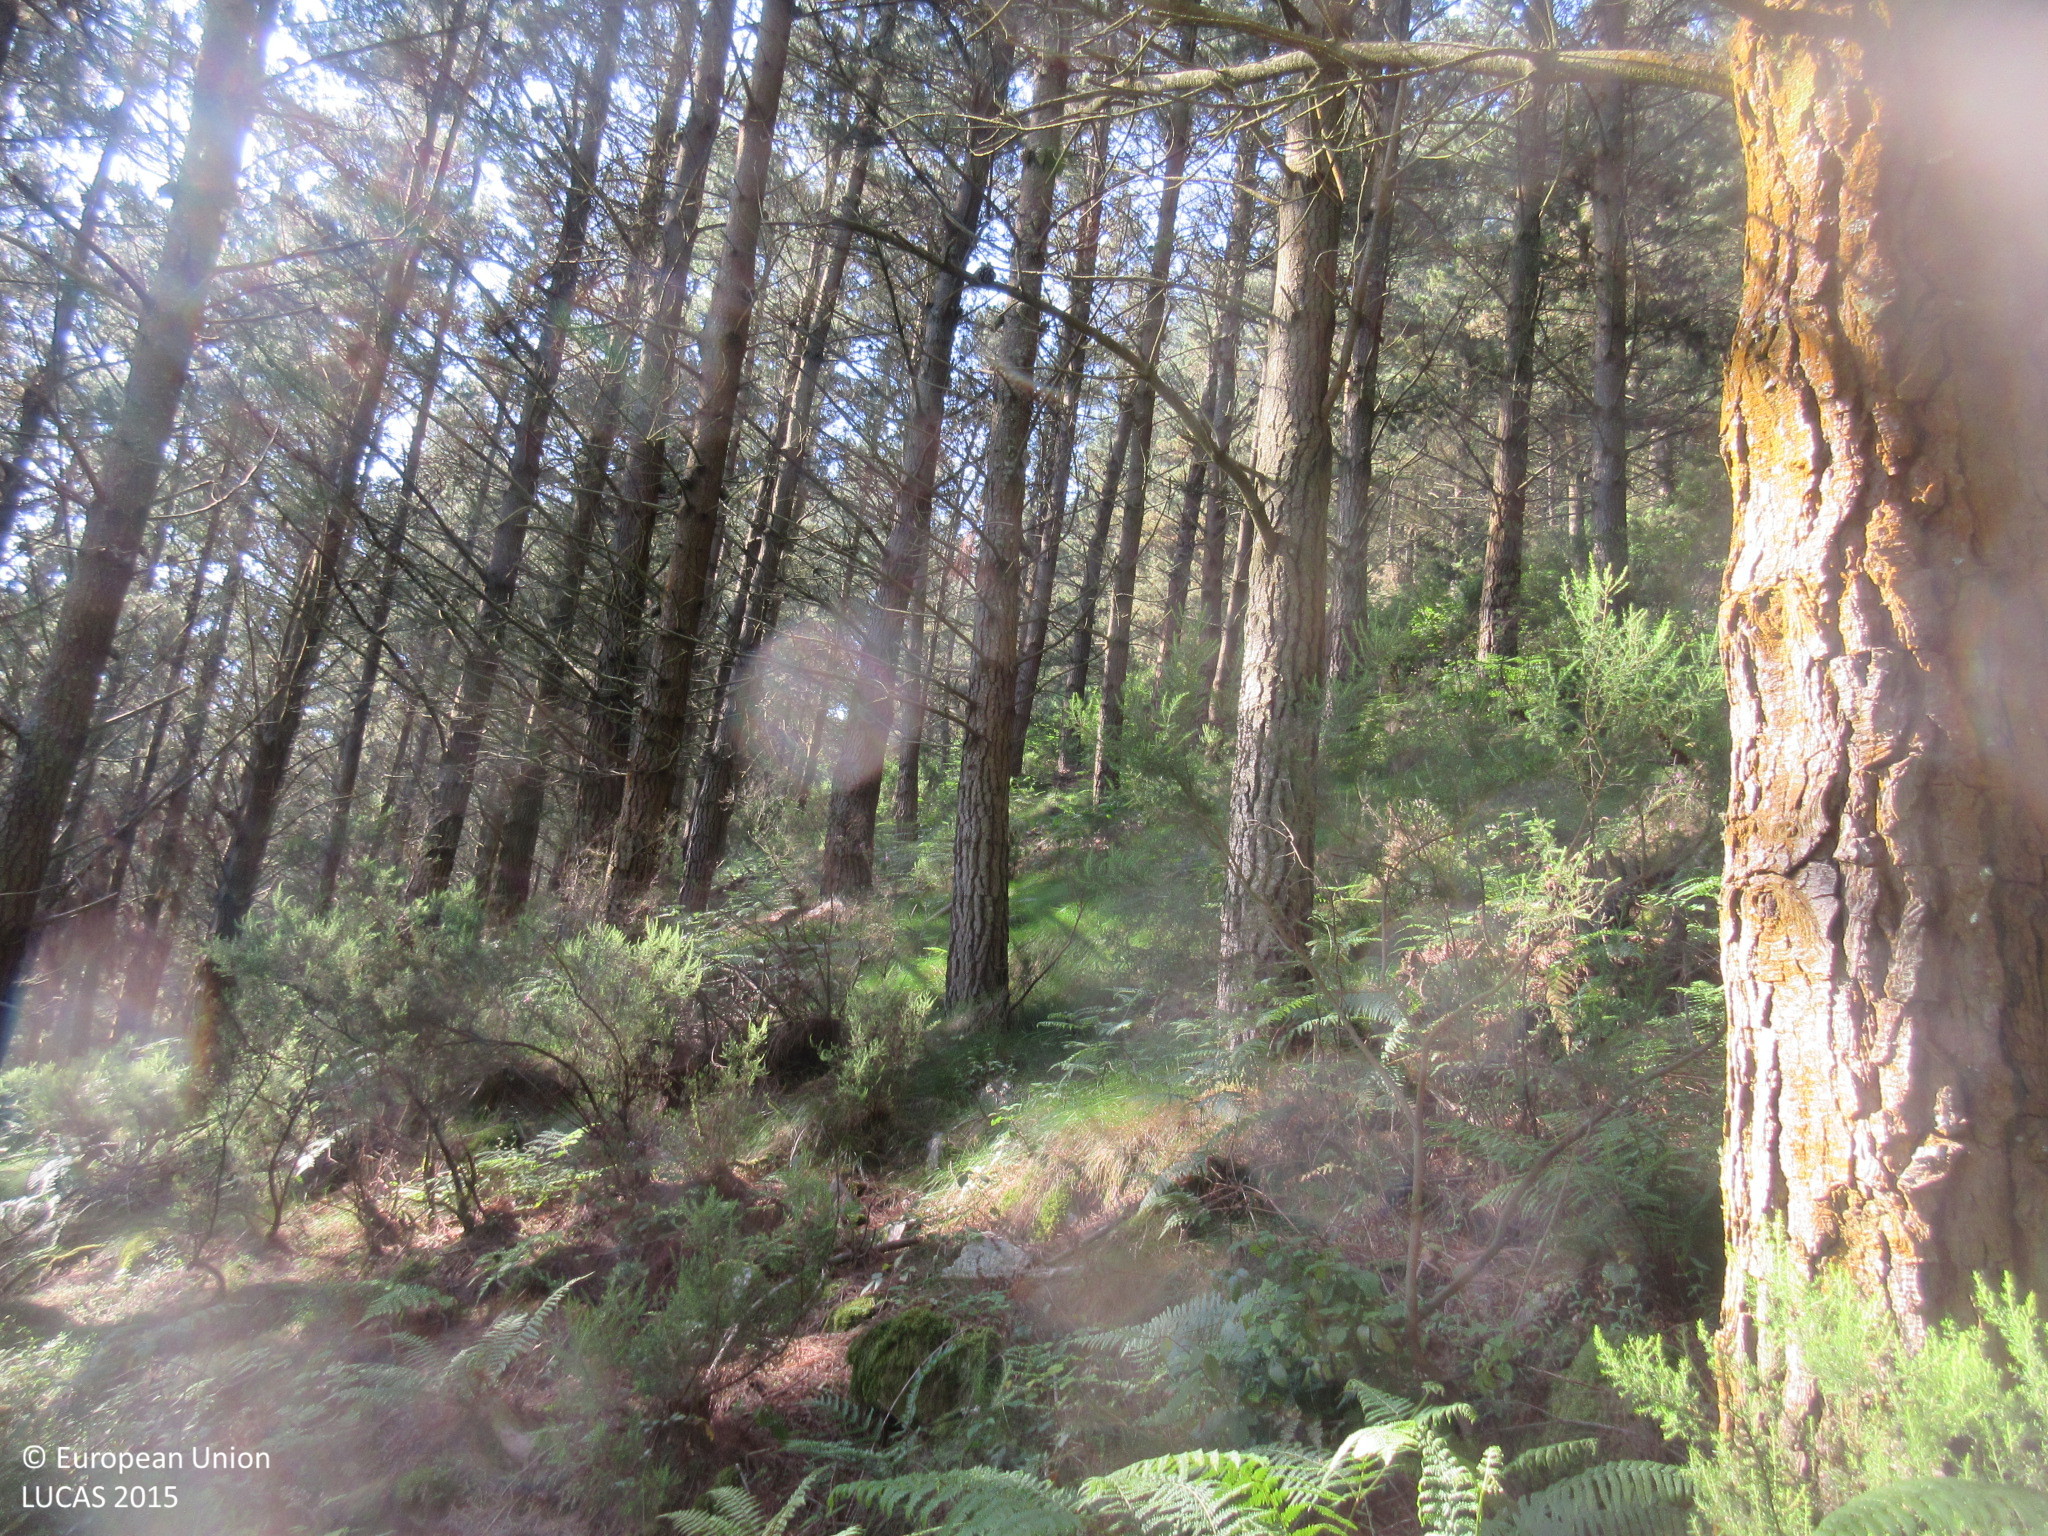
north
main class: Woodland
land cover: Pine dominated coniferous woodland
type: hemiboreal forest and nemoral coniferous forest and mixed broadleaved-coniferous forest
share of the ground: > 75 %
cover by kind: coniferous forest trees 95 %, shrubs 5 %
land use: Forestry
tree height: > 5 m
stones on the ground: > 50 %
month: June
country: ES
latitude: 43.4058
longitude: -7.0470
